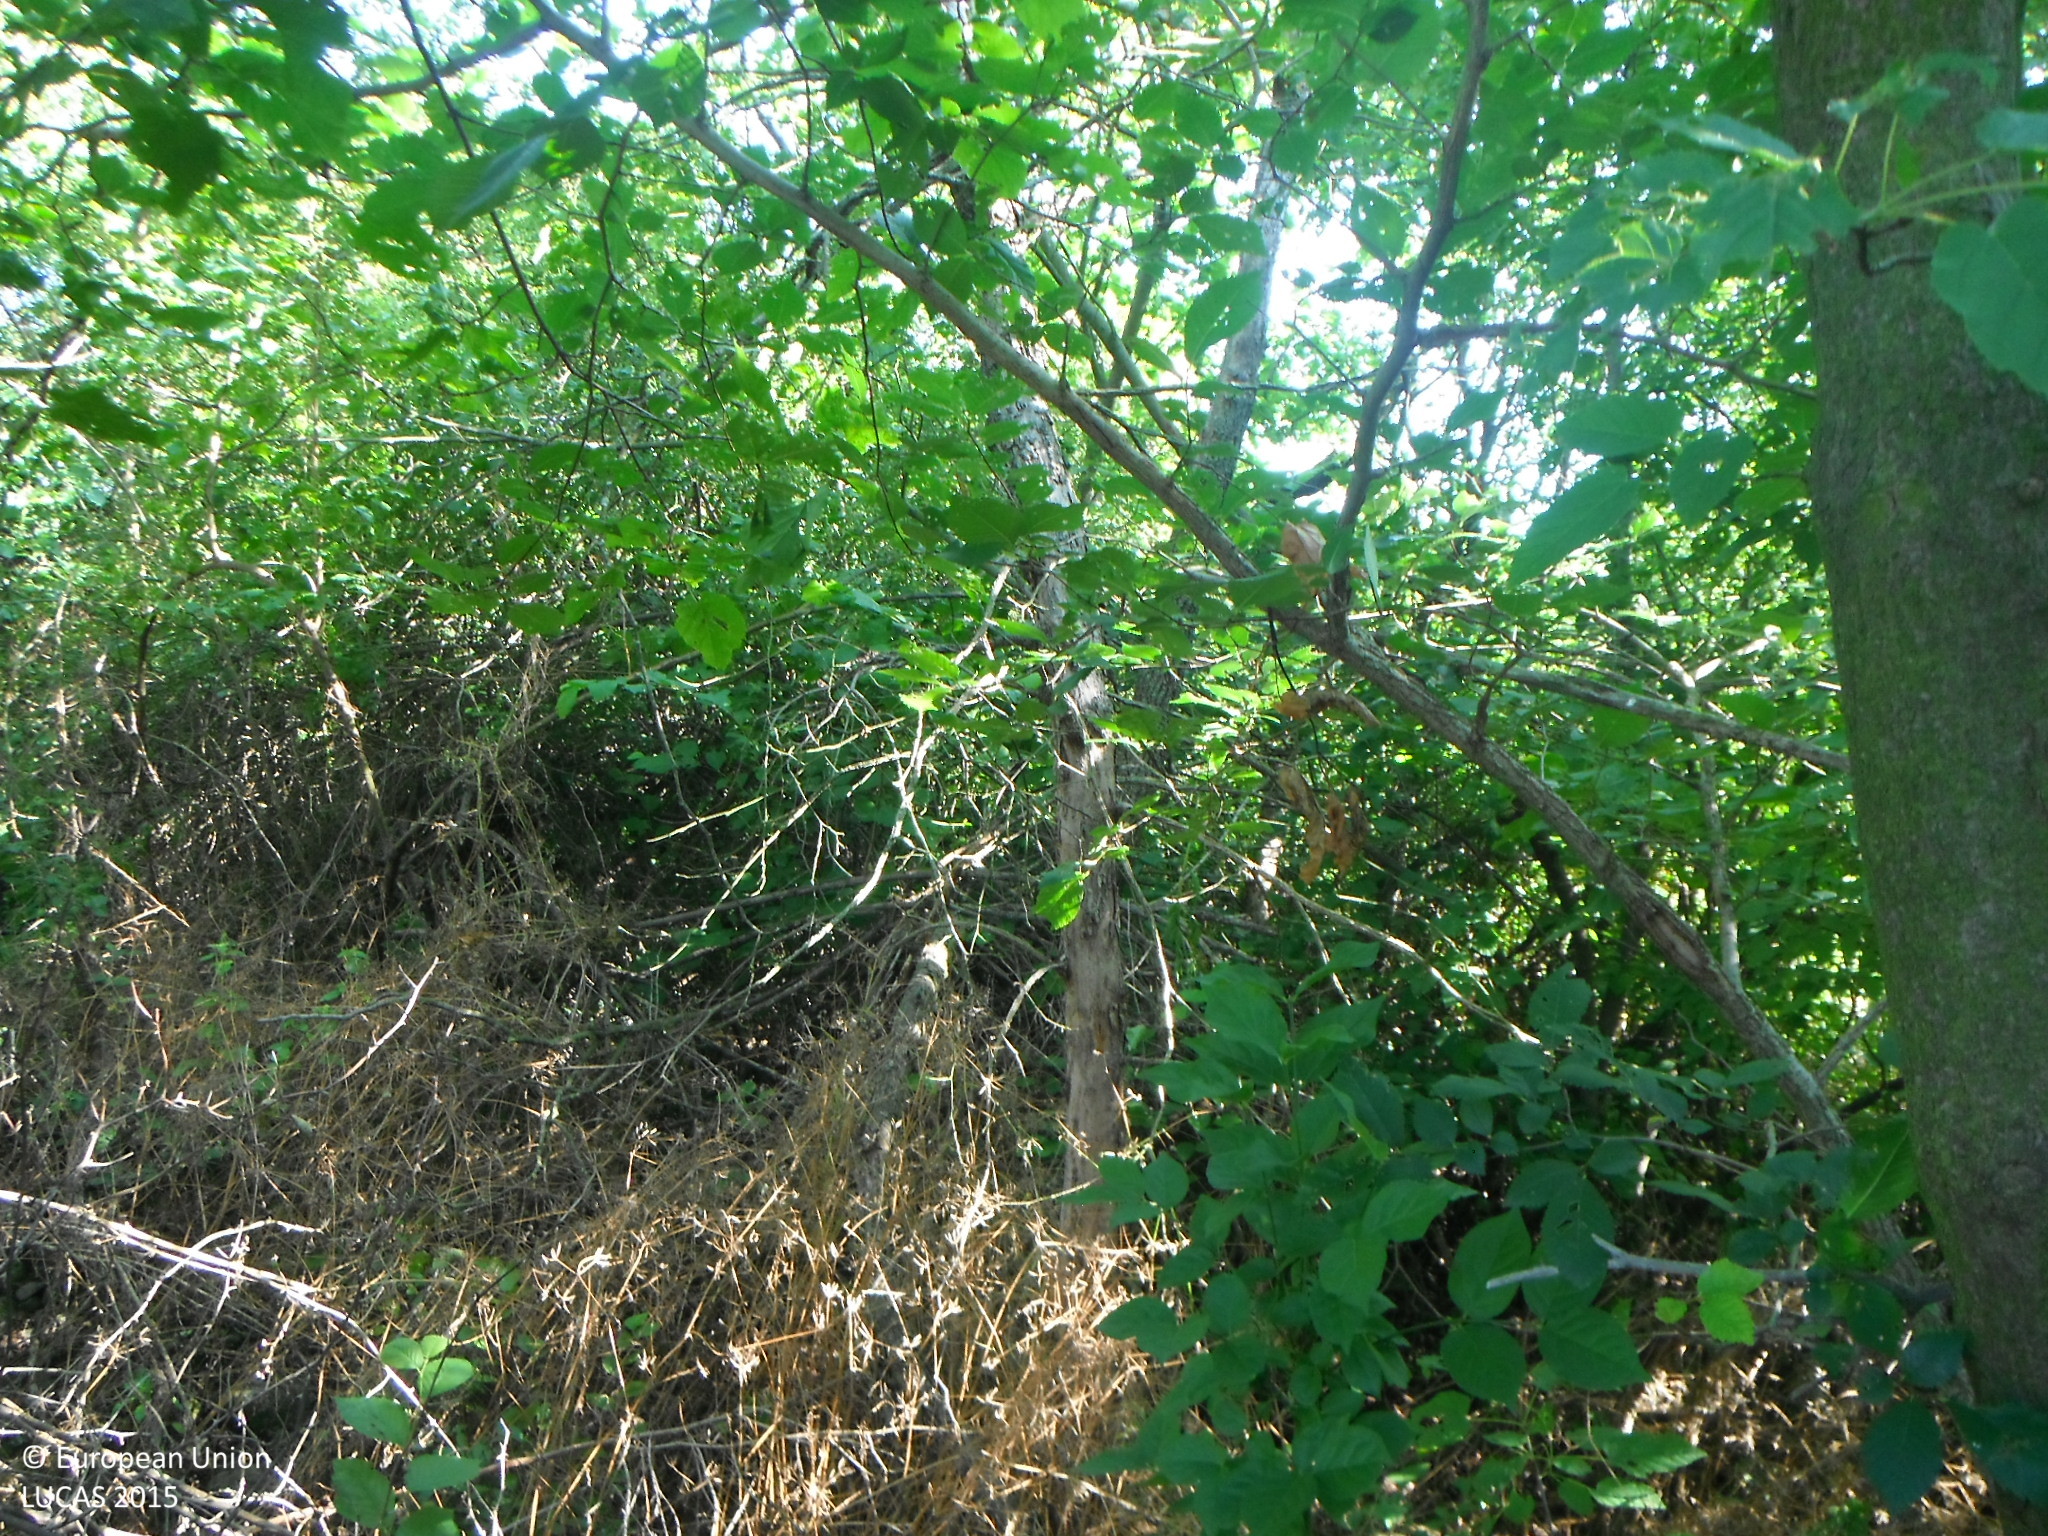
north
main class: Shrubland
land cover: Shrubland with sparse tree cover
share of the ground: > 75 %
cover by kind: shrubs 95 %, broadleaved forest trees 5 %
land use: Semi-natural and natural areas not in use
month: June
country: SK
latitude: 48.2058
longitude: 18.9136
